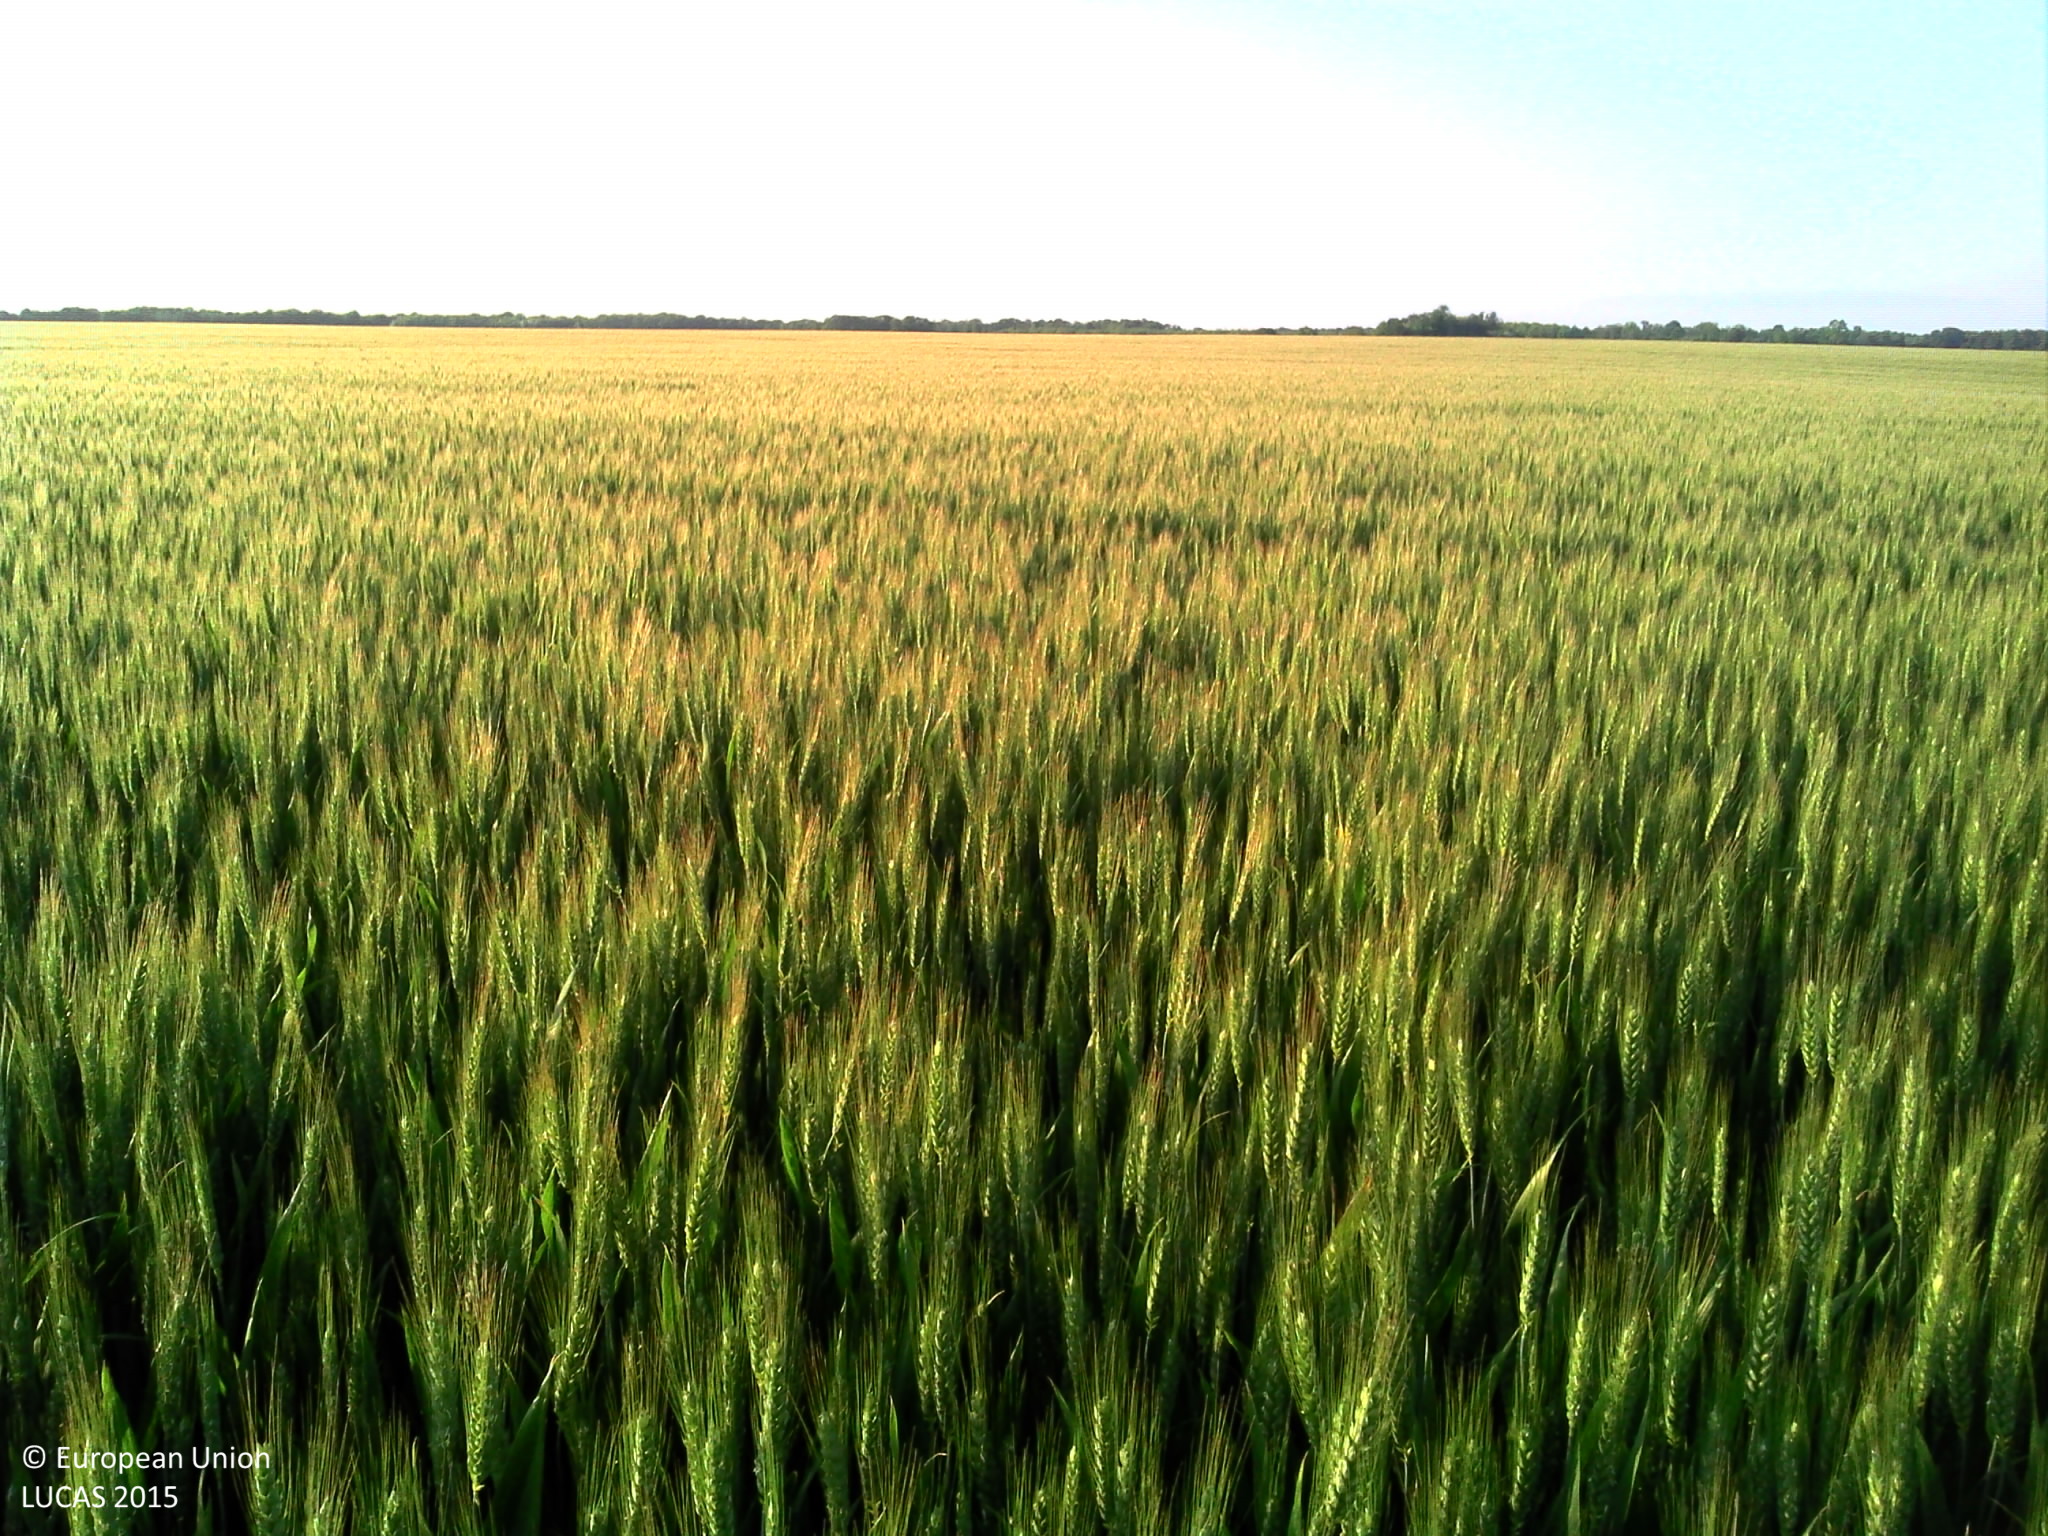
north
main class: Cropland
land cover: Rye
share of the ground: > 75 %
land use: Agriculture (excluding fallow land and kitchen gardens)
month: May
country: FR
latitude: 48.5917
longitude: 4.8866
